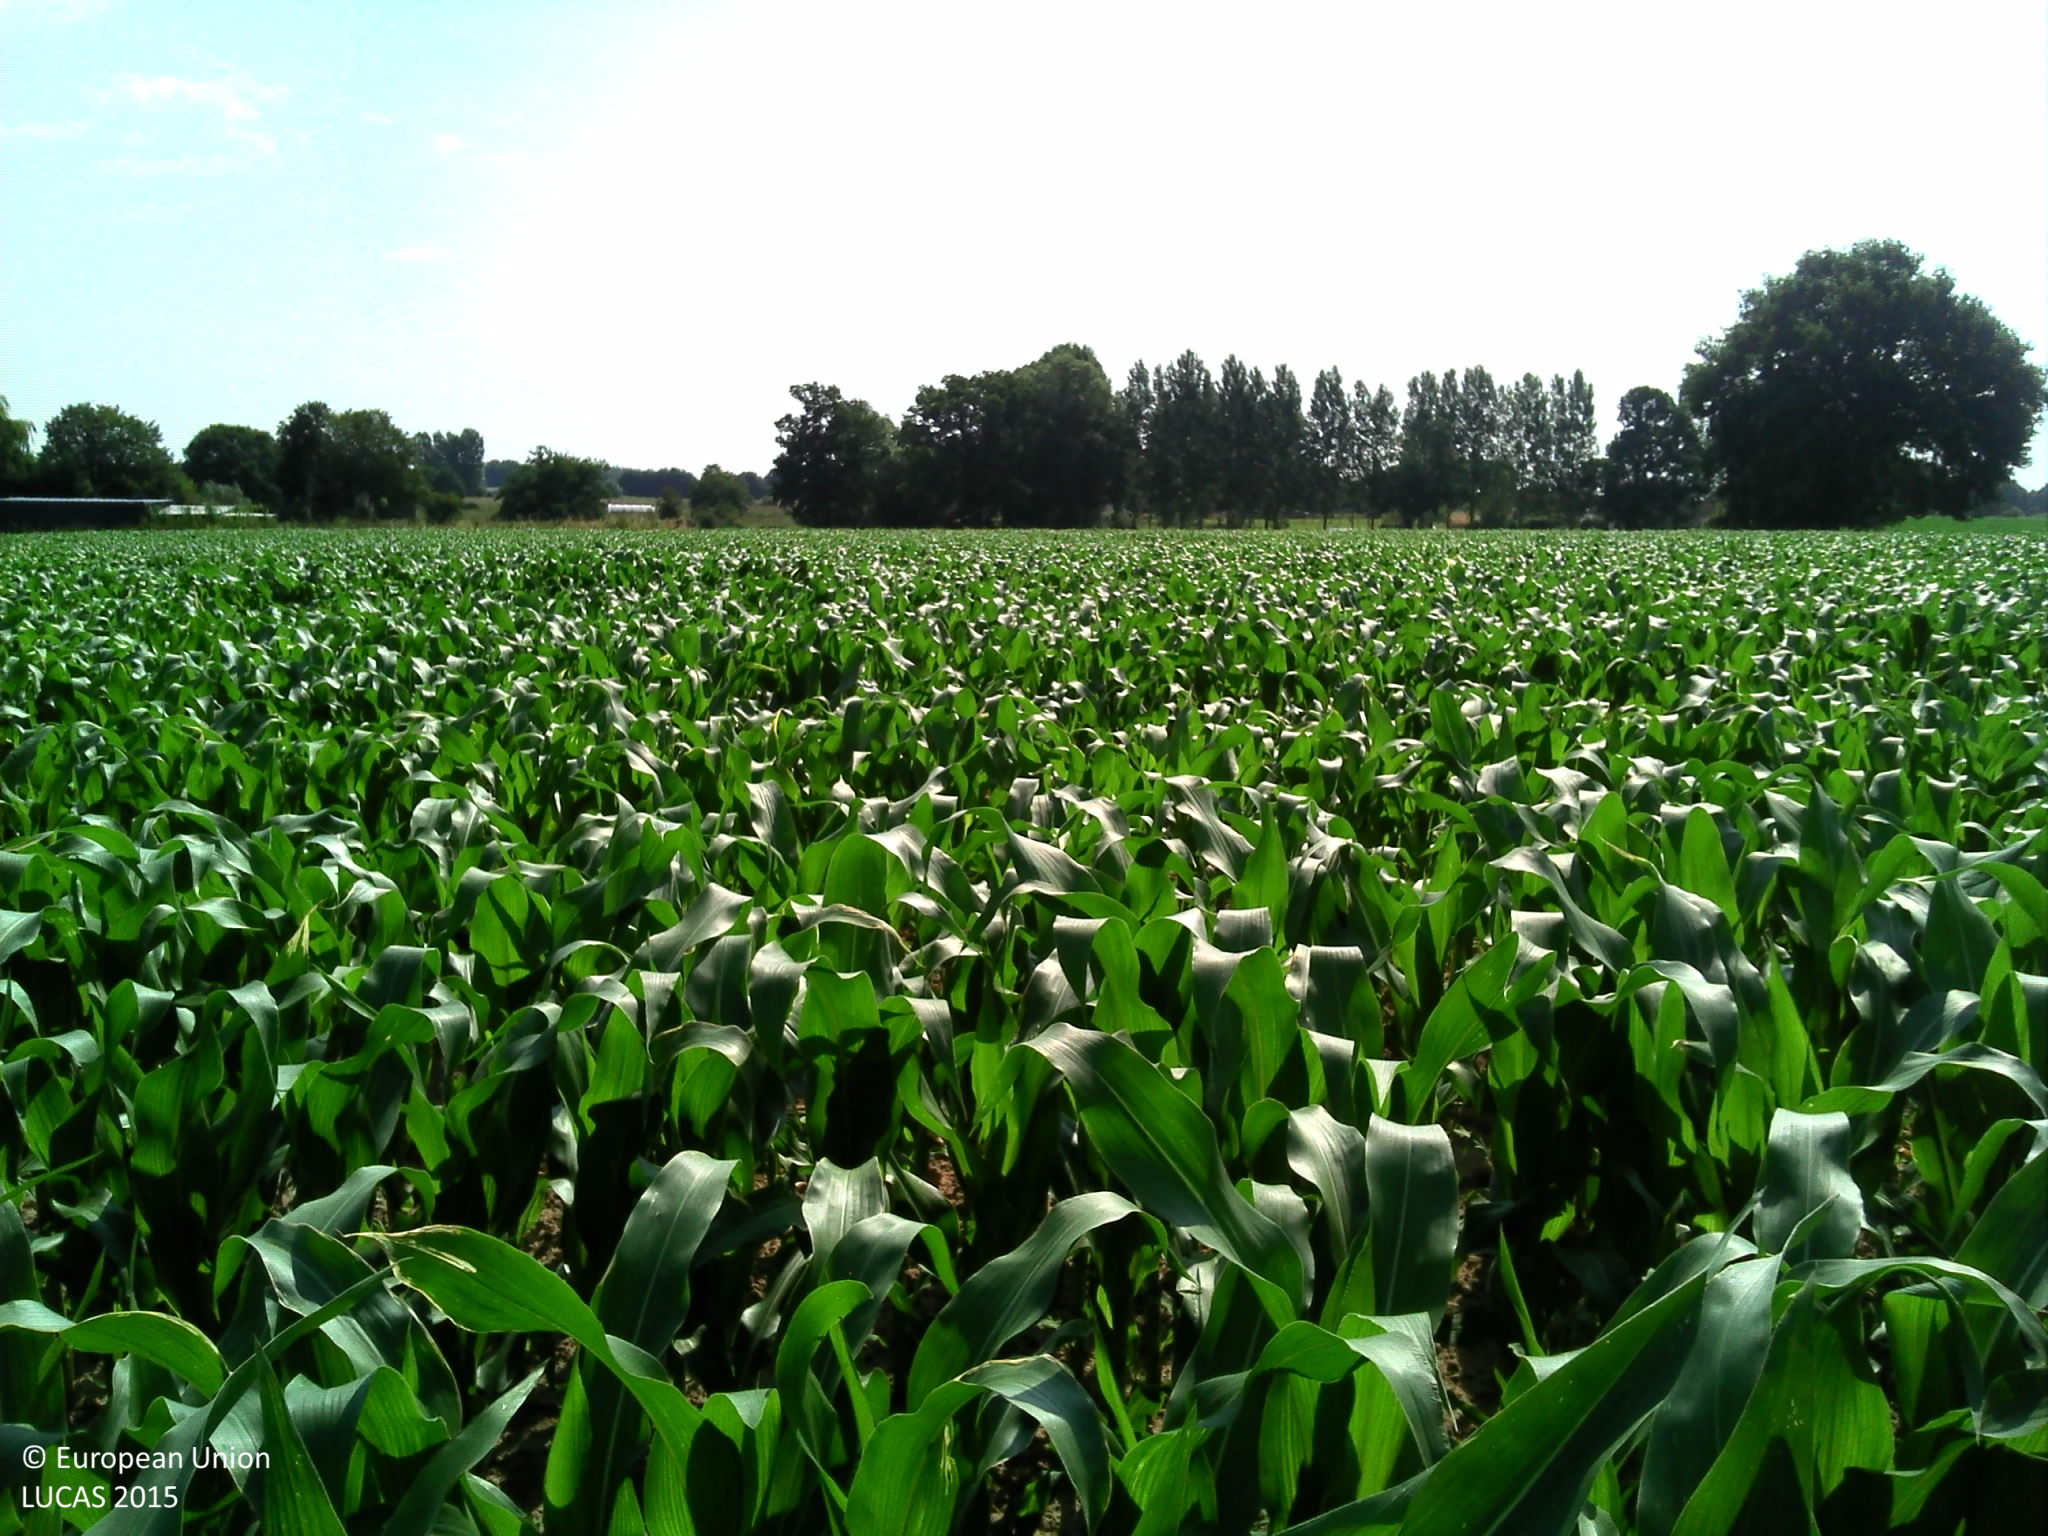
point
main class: Cropland
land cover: Maize
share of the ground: > 75 %
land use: Agriculture (excluding fallow land and kitchen gardens)
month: July
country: FR
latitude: 47.8231
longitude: 0.2107
